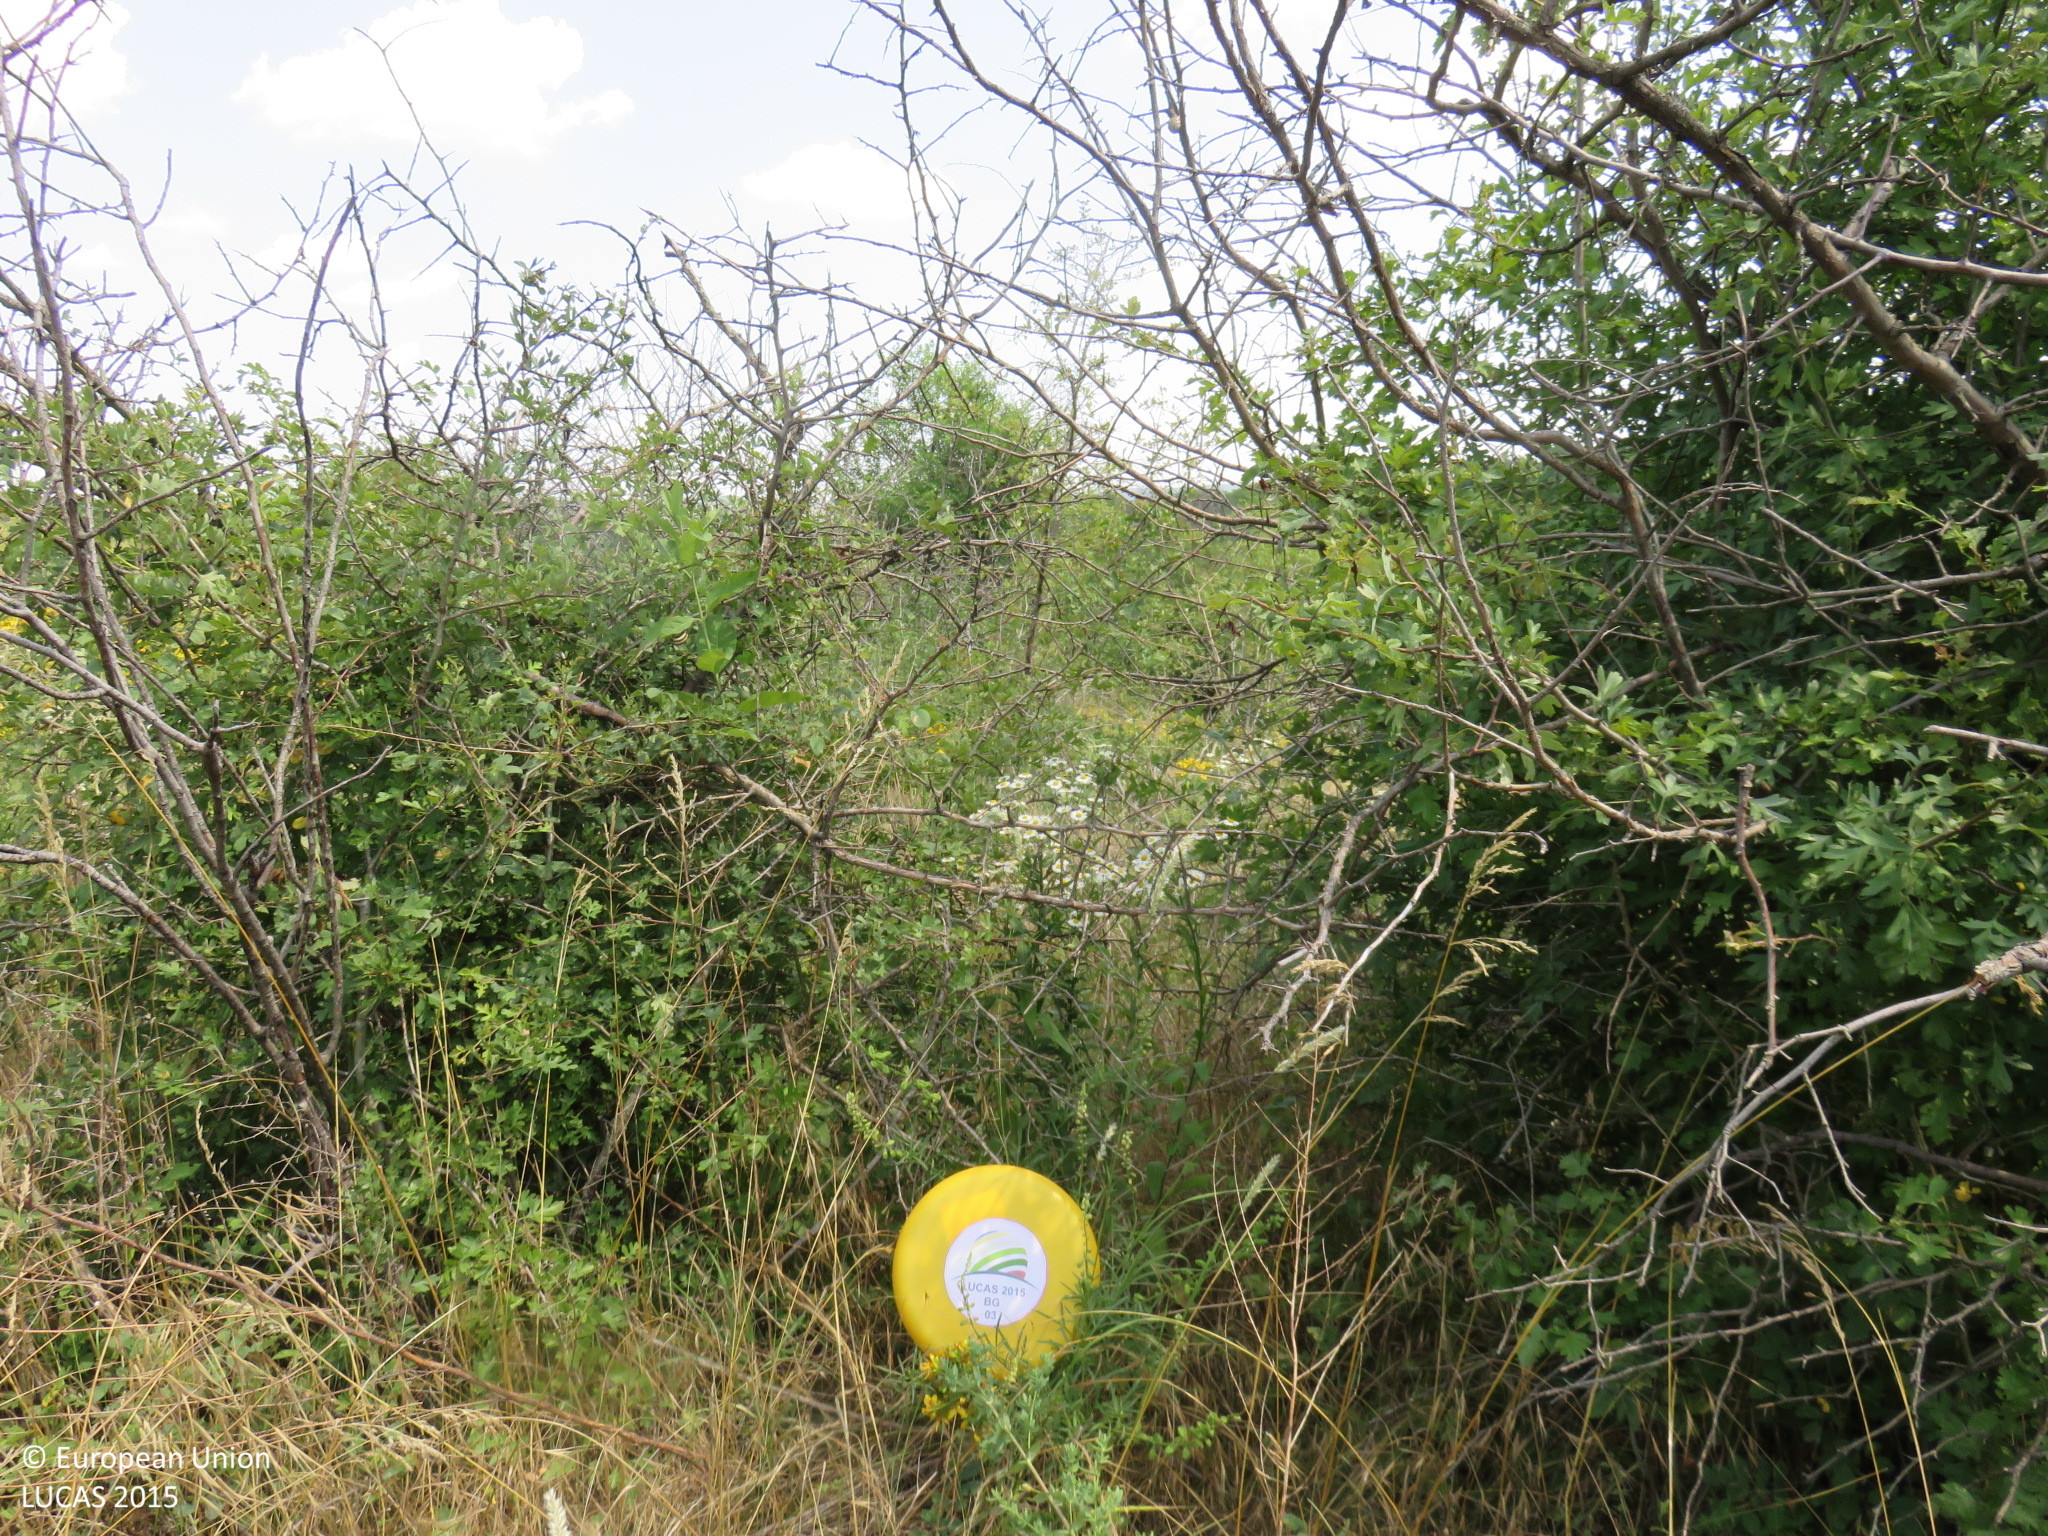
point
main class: Cropland
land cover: Other fruit trees and berries
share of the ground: 25 - 50 %
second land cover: Spontaneously vegetated surfaces
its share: > 75 %
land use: Abandoned areas
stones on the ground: < 10 %
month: June
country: BG
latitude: 43.6679
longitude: 24.4106
